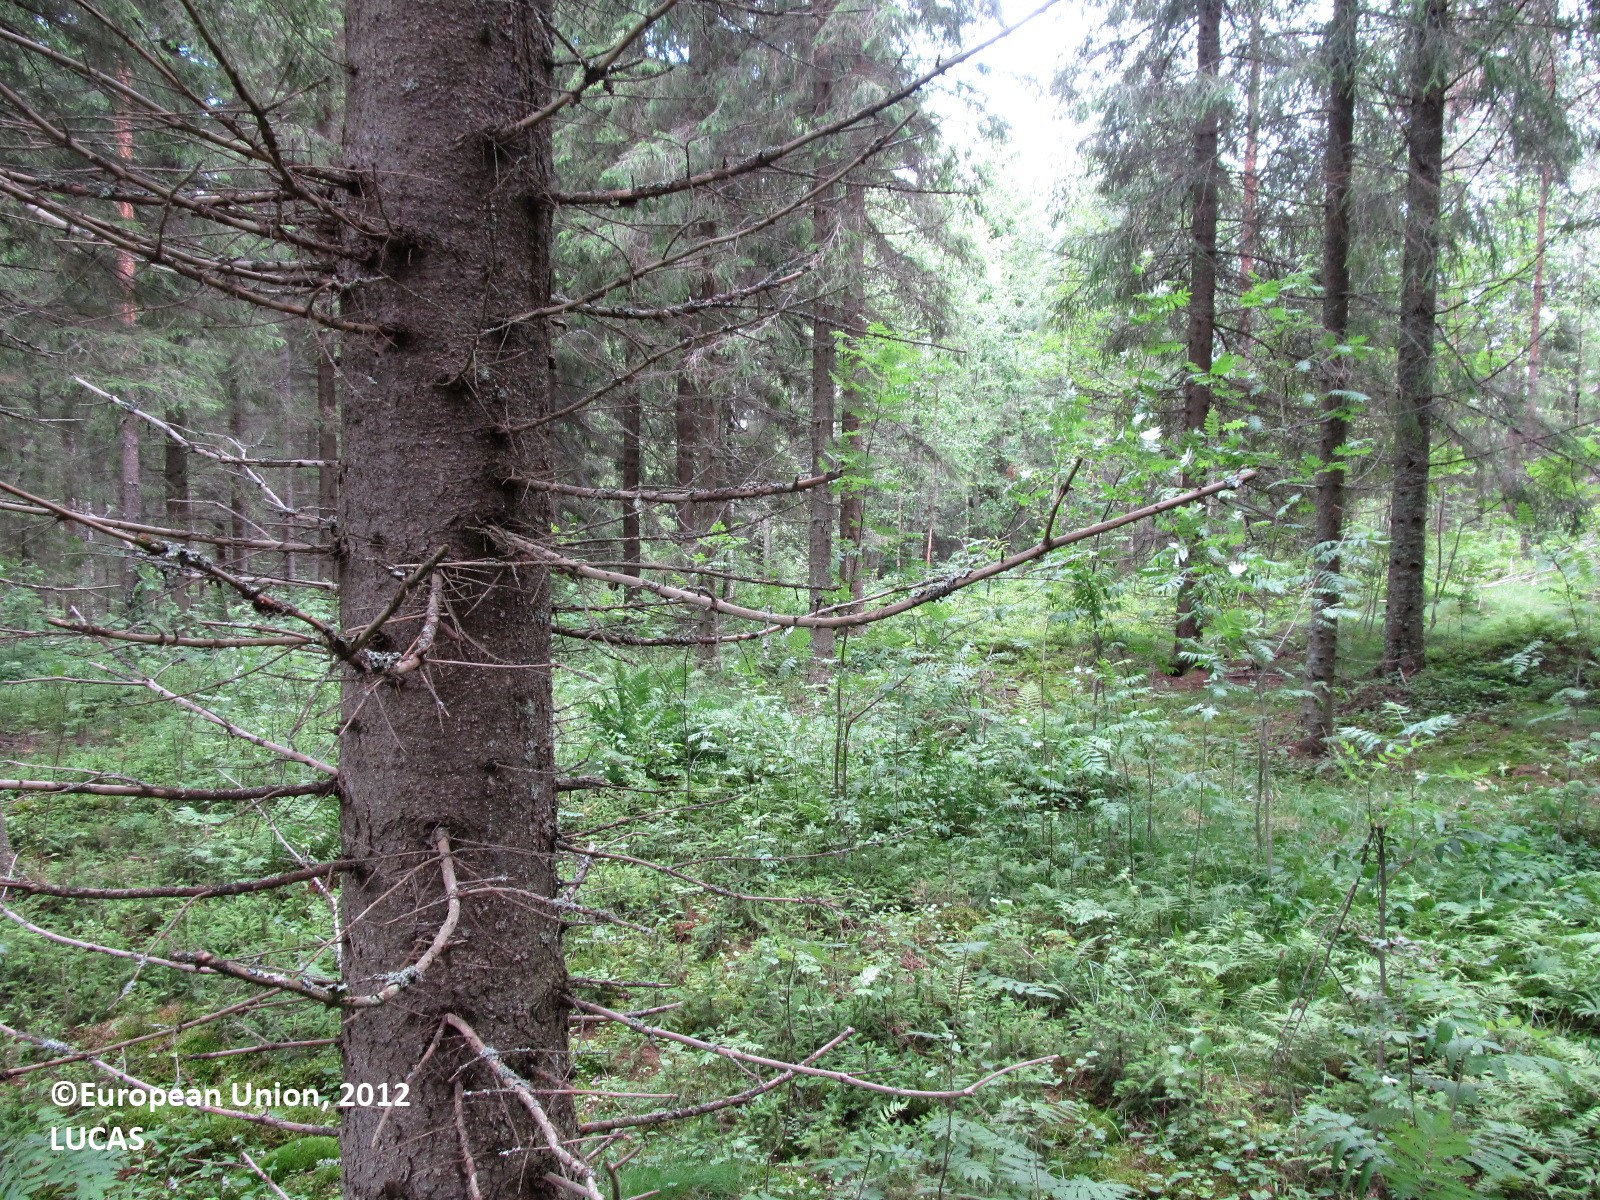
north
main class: Woodland
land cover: Spruce dominated coniferous woodland
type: boreal forest
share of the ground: 50 - 75 %
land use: Forestry
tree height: > 5 m
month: July
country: FI
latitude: 61.8989
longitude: 29.0499
